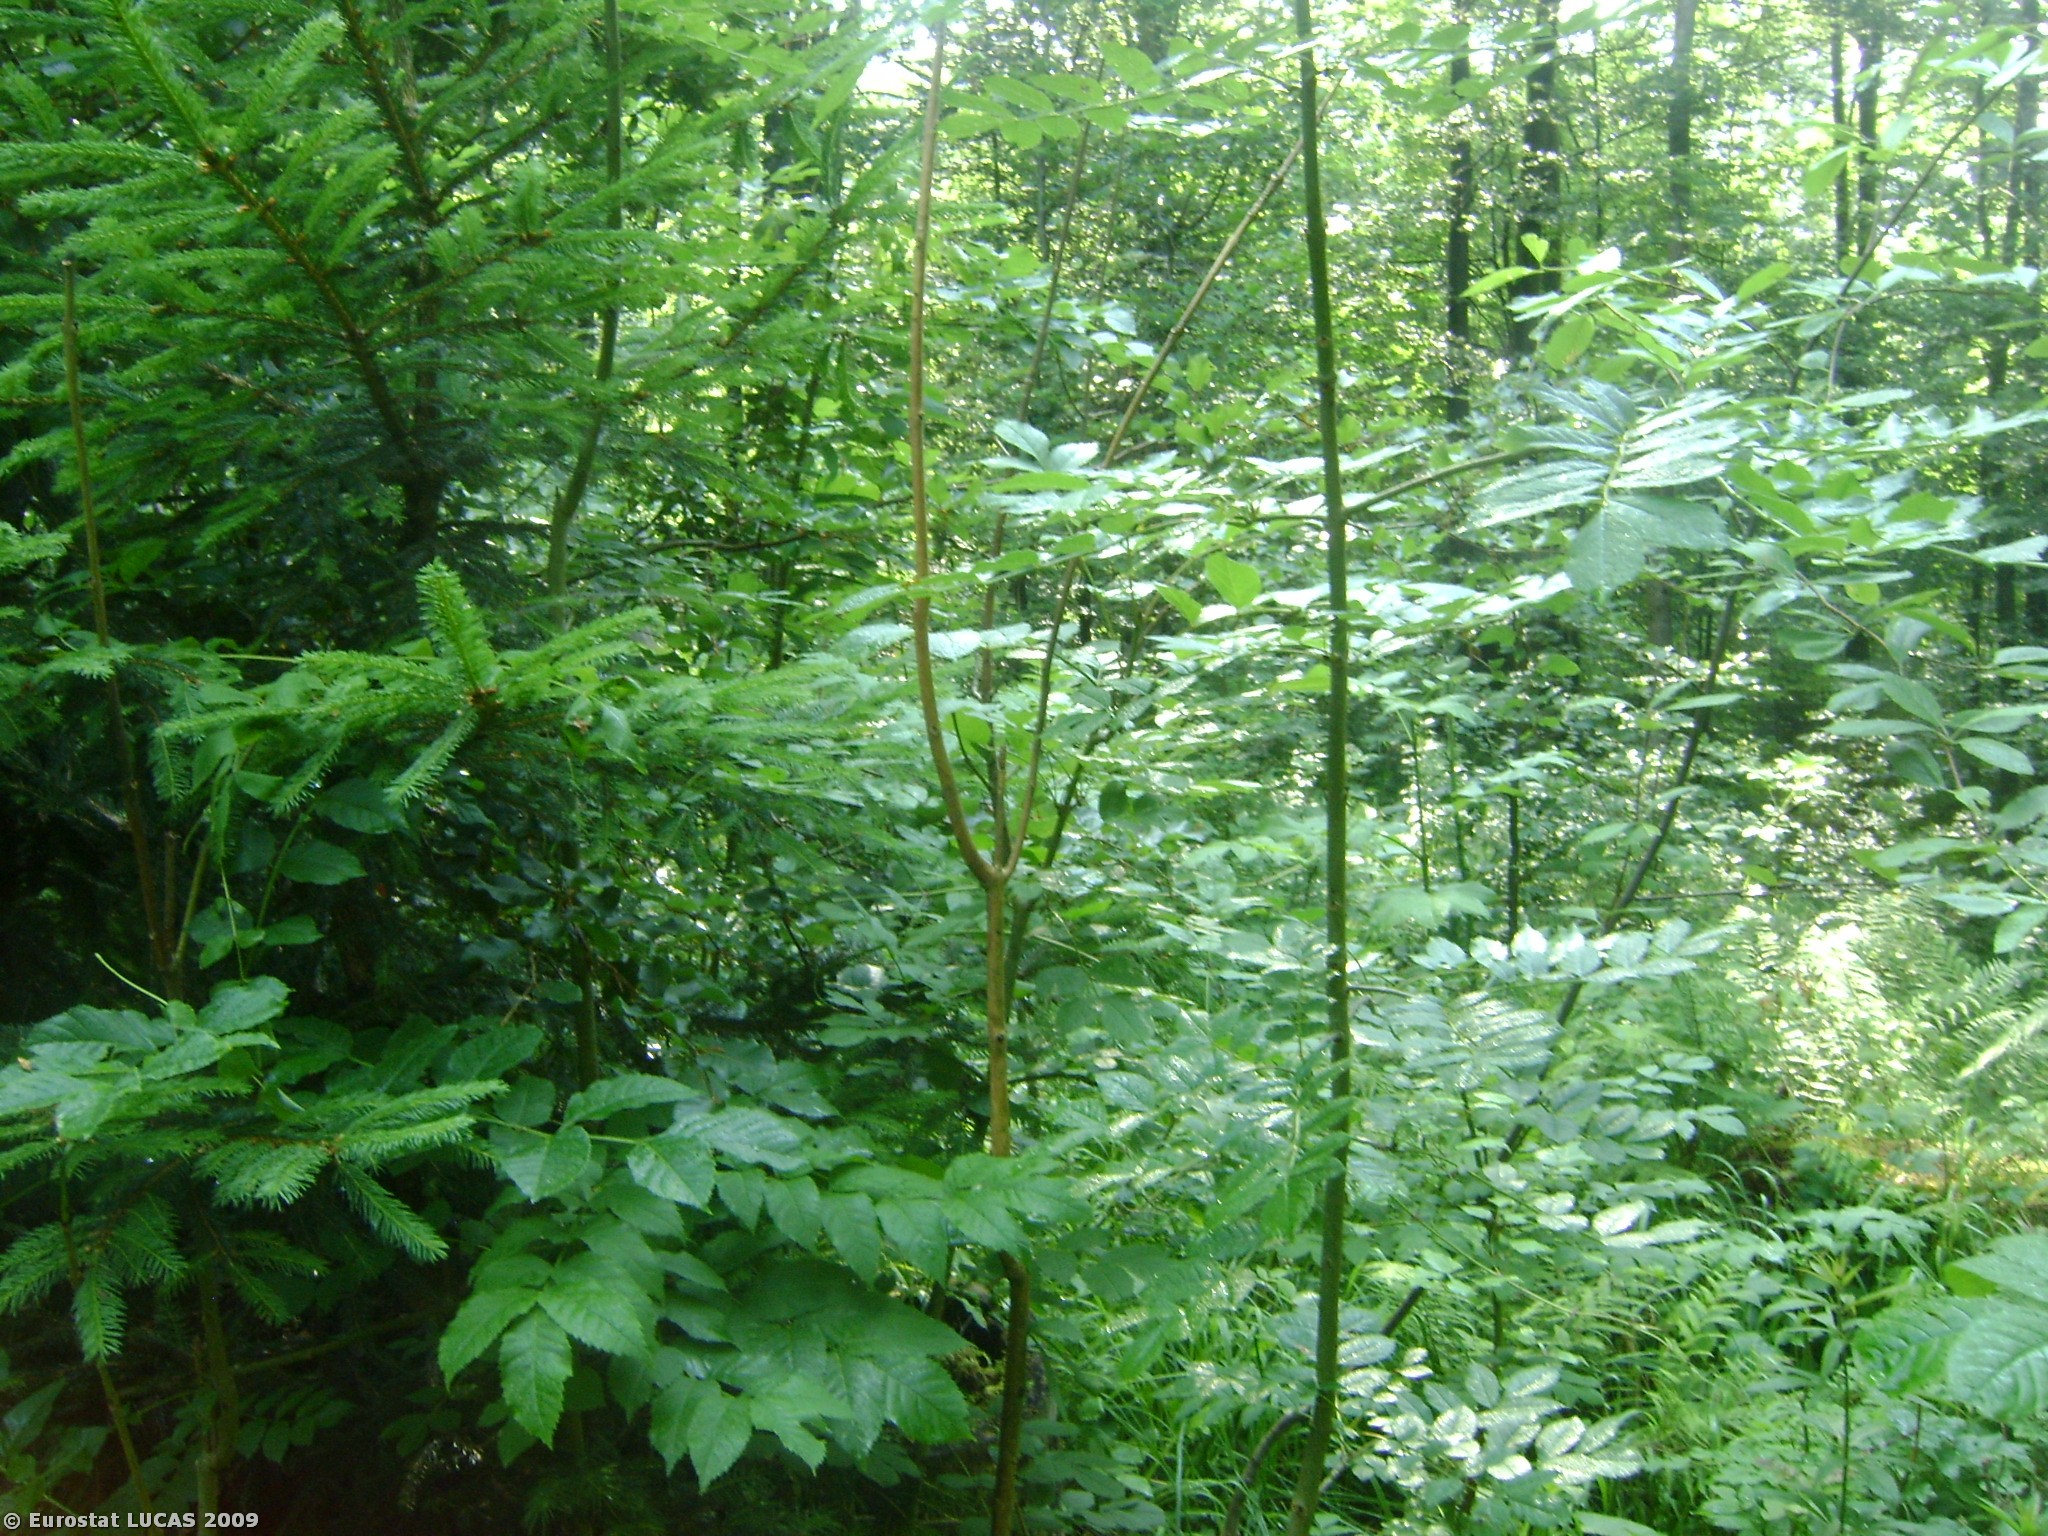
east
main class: Woodland
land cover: Mixed woodland
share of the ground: > 75 %
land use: Forestry
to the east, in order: Mixed woodland; Ditches and canals; Mixed woodland; Tracks; Broadleaved woodland; Ditches and canals; Broadleaved woodland
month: July
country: AT
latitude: 47.7781
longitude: 13.2950
